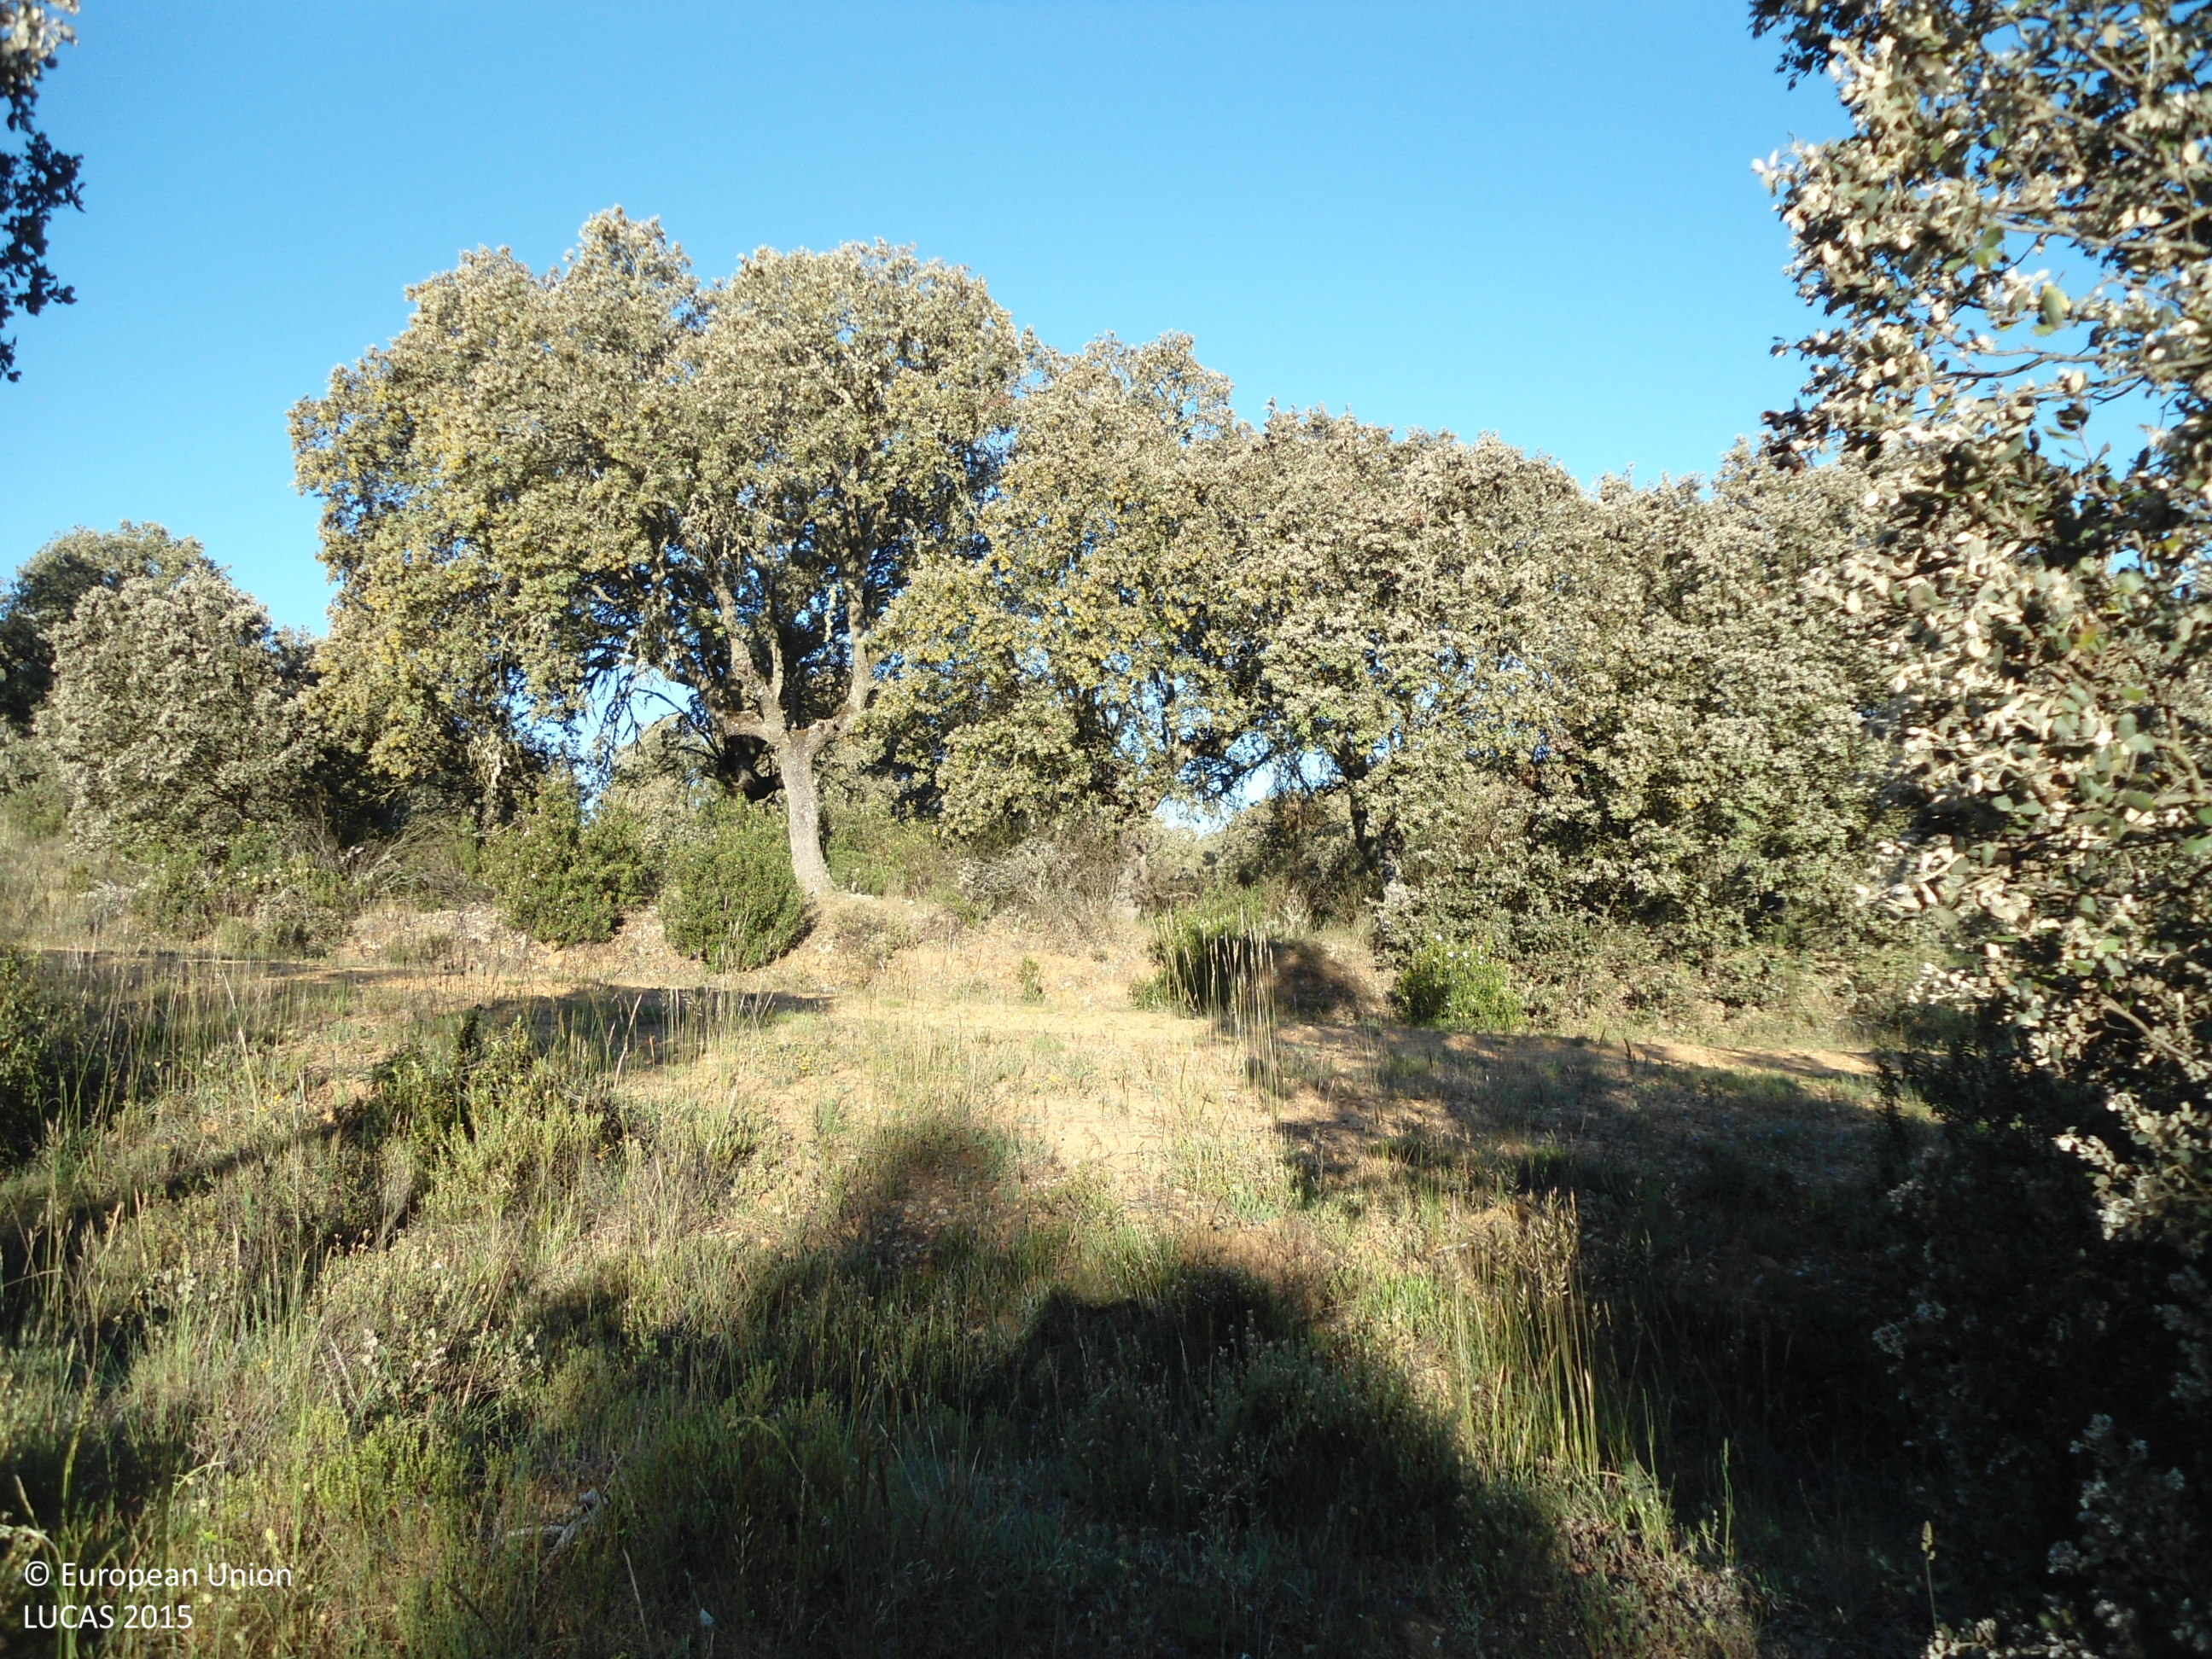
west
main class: Woodland
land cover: Broadleaved woodland
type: broadleaved evergreen forest
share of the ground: 50 - 75 %
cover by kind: broadleaved forest trees 60 %, shrubs 20 %, herbaceous plants 20 %
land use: Forestry
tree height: > 5 m
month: May
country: ES
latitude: 41.9700
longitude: -5.9410
